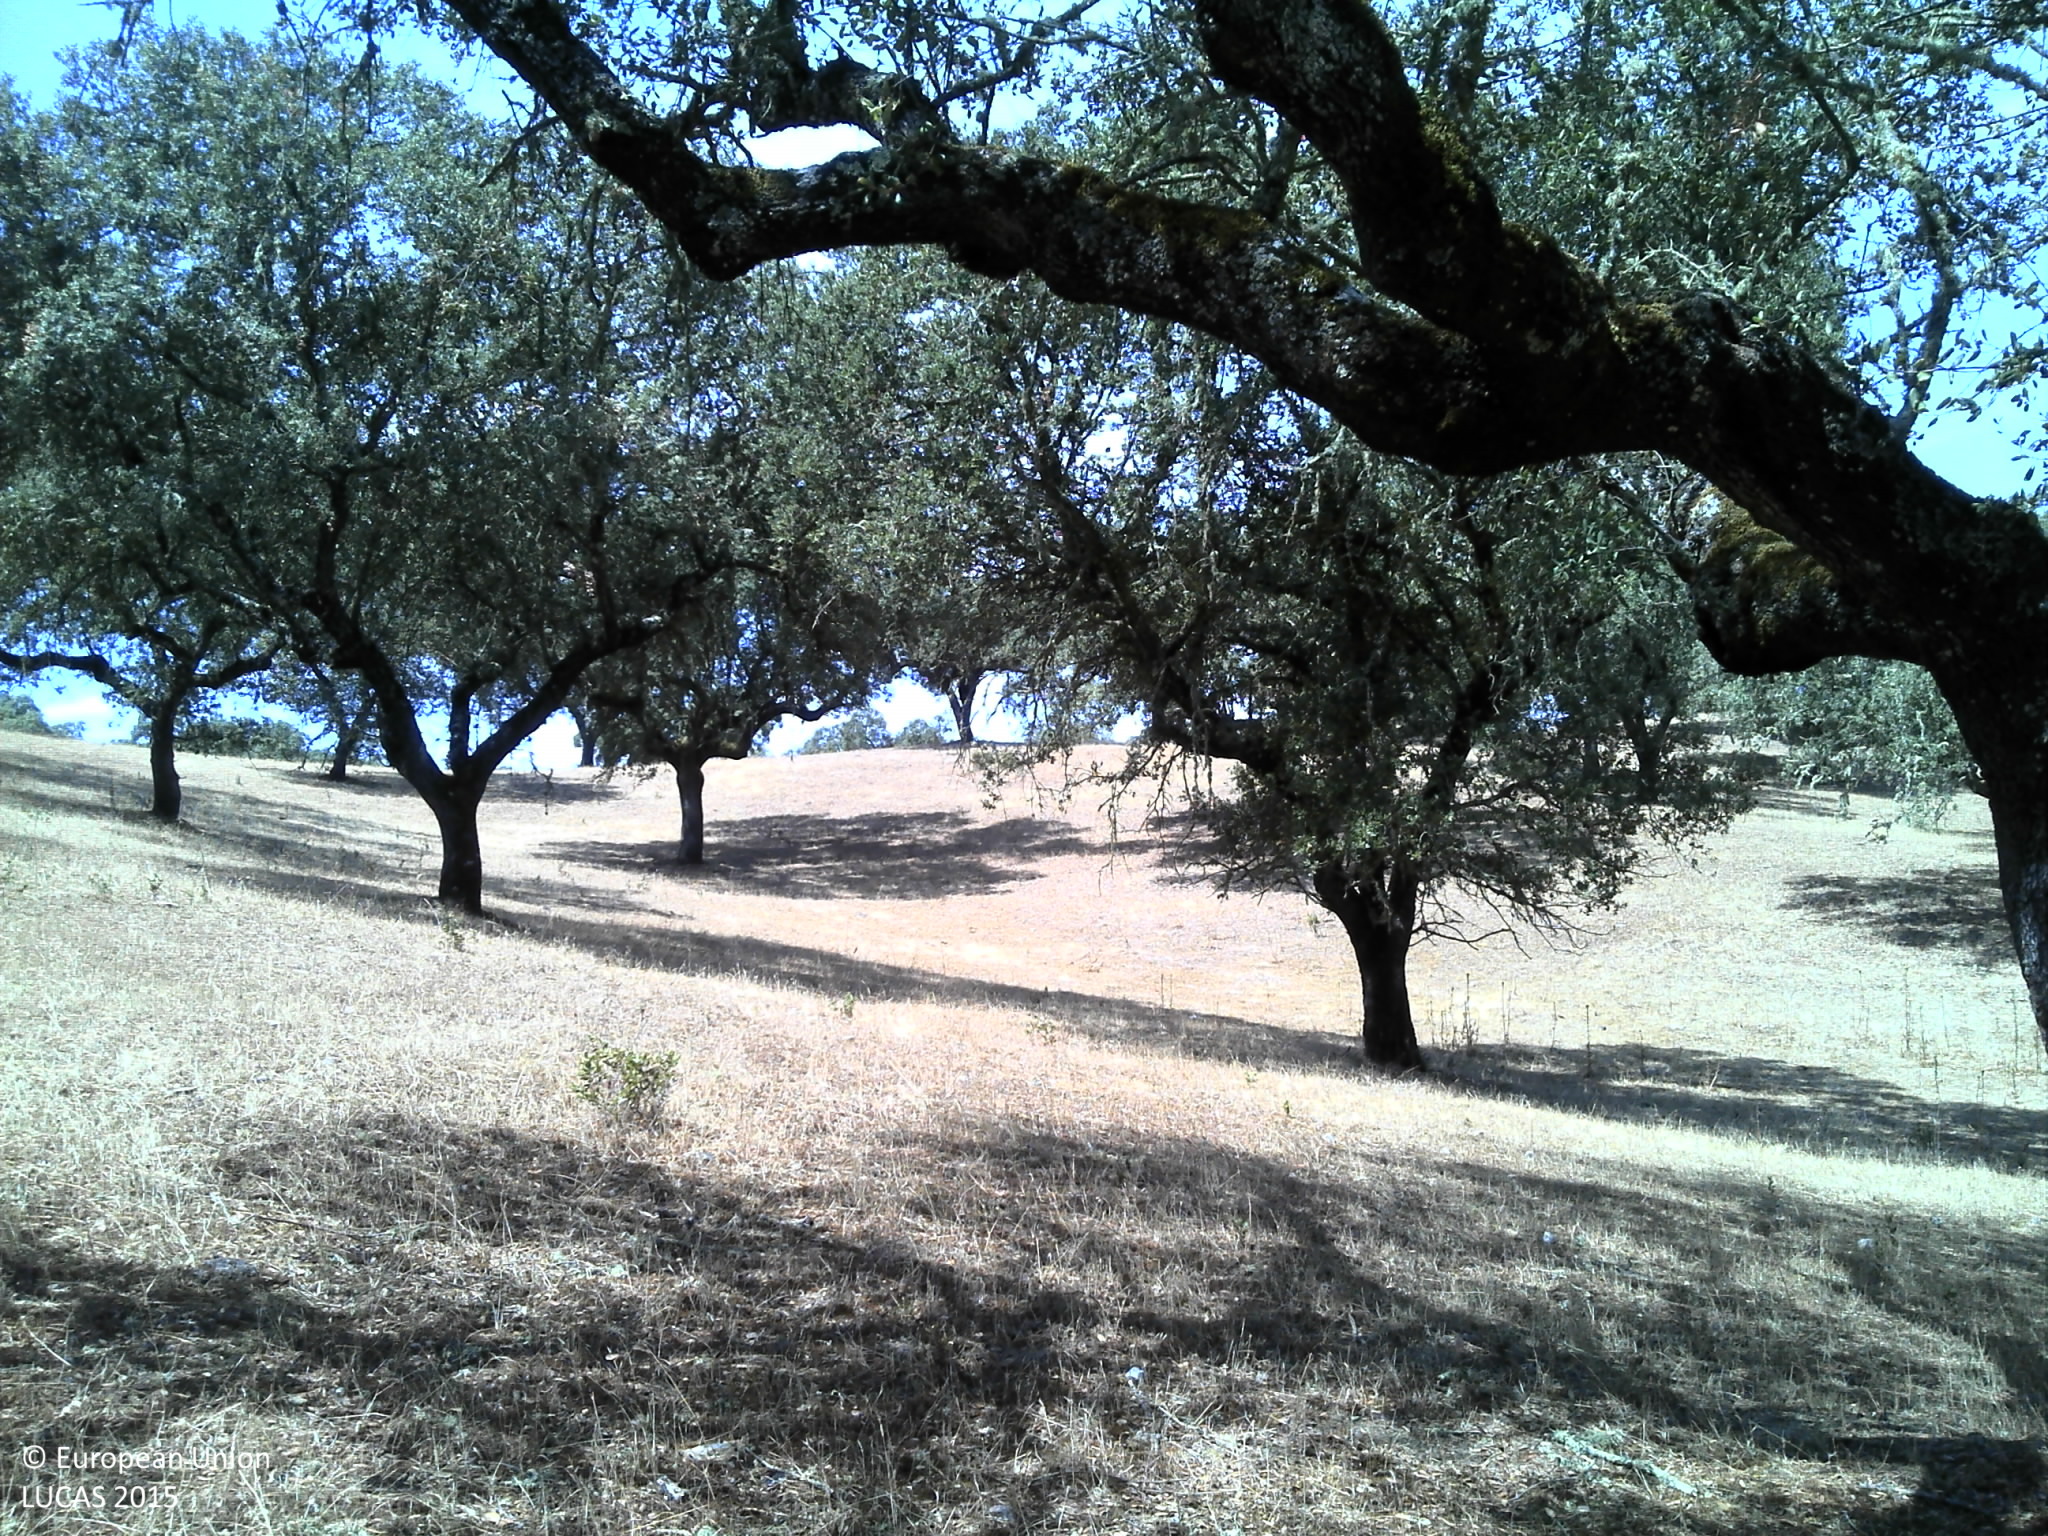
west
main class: Woodland
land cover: Broadleaved woodland
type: broadleaved evergreen forest
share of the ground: 25 - 50 %
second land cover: Grassland without tree/shrub cover
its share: 25 - 50 %
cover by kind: broadleaved forest trees 40 %, unconsolidated bare surface 35 %, herbaceous plants 25 %
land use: Forestry
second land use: Agriculture (excluding fallow land and kitchen gardens)
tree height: > 5 m
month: July
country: PT
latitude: 38.4819
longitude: -7.6746
